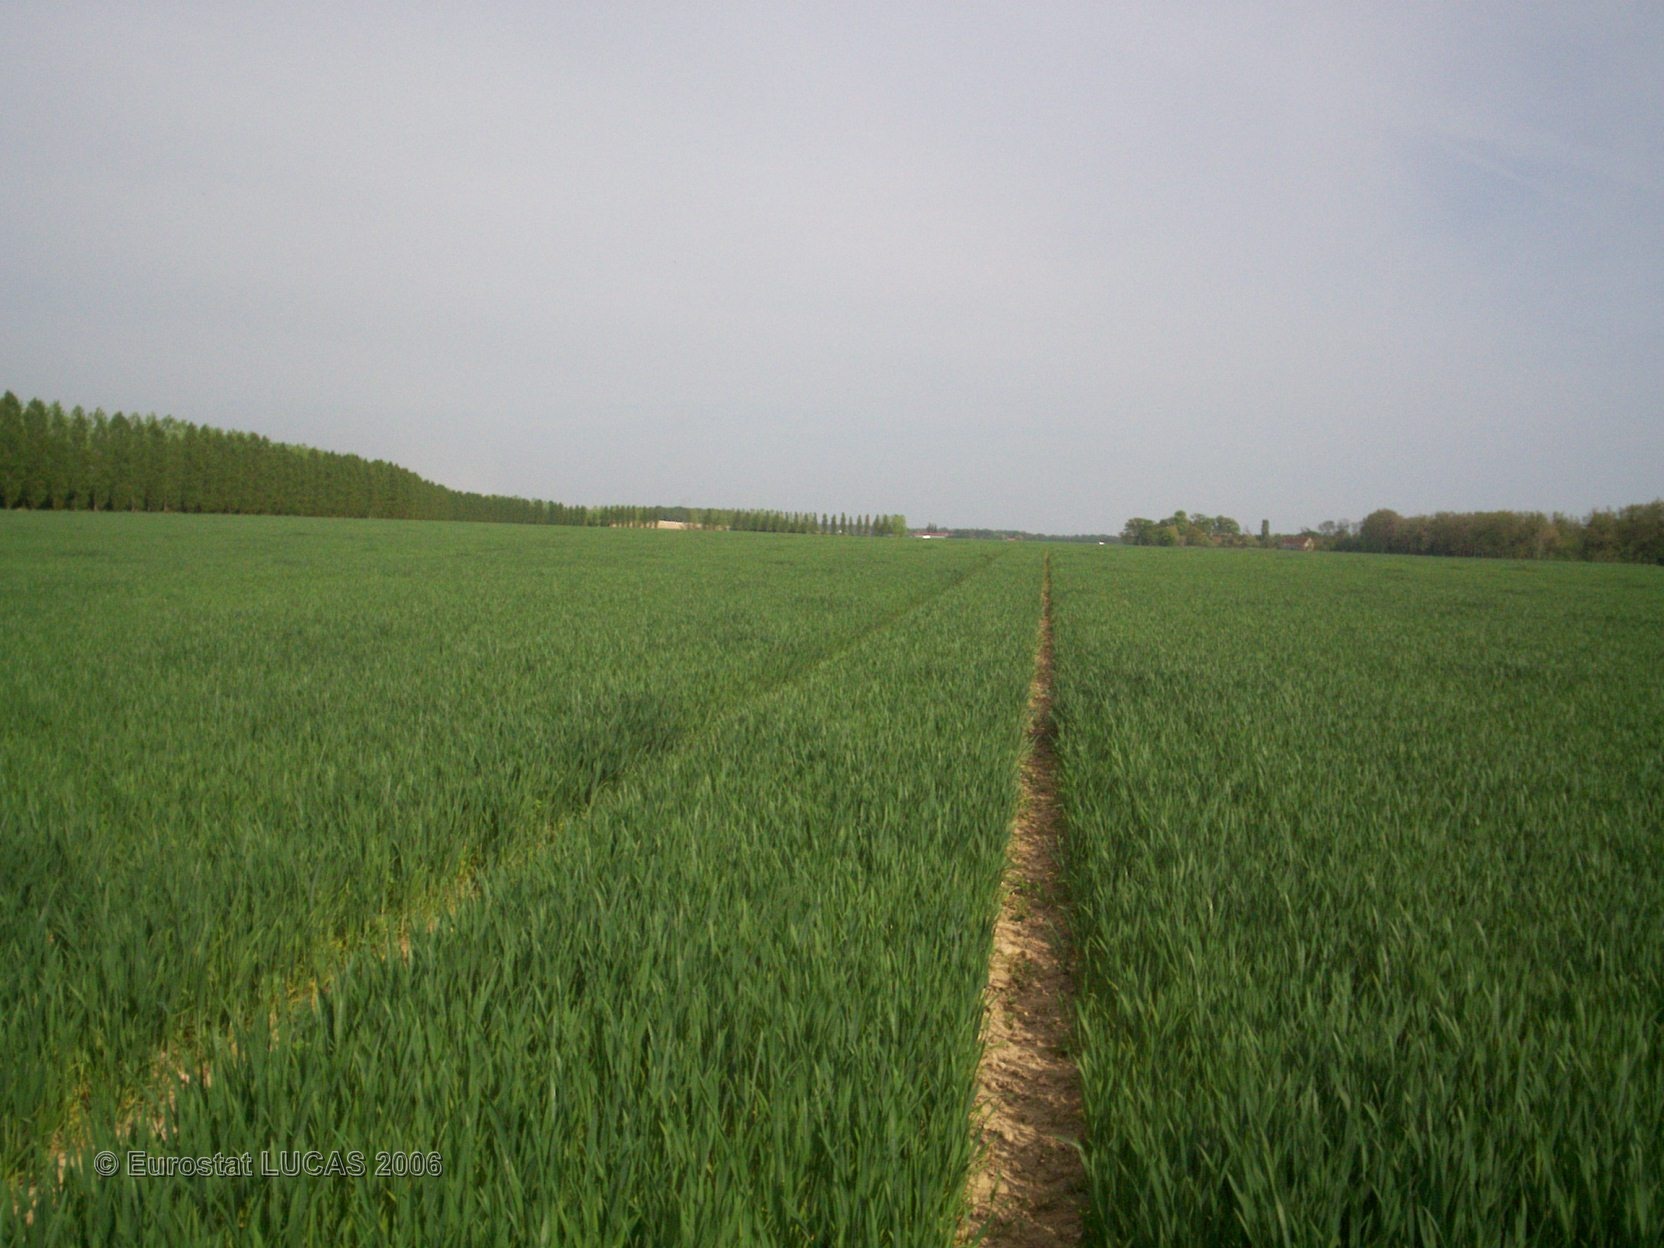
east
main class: Cropland
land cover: Common wheat
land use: Agriculture (excluding fallow land and kitchen gardens)
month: May
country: FR
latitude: 48.7285
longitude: 2.7988
